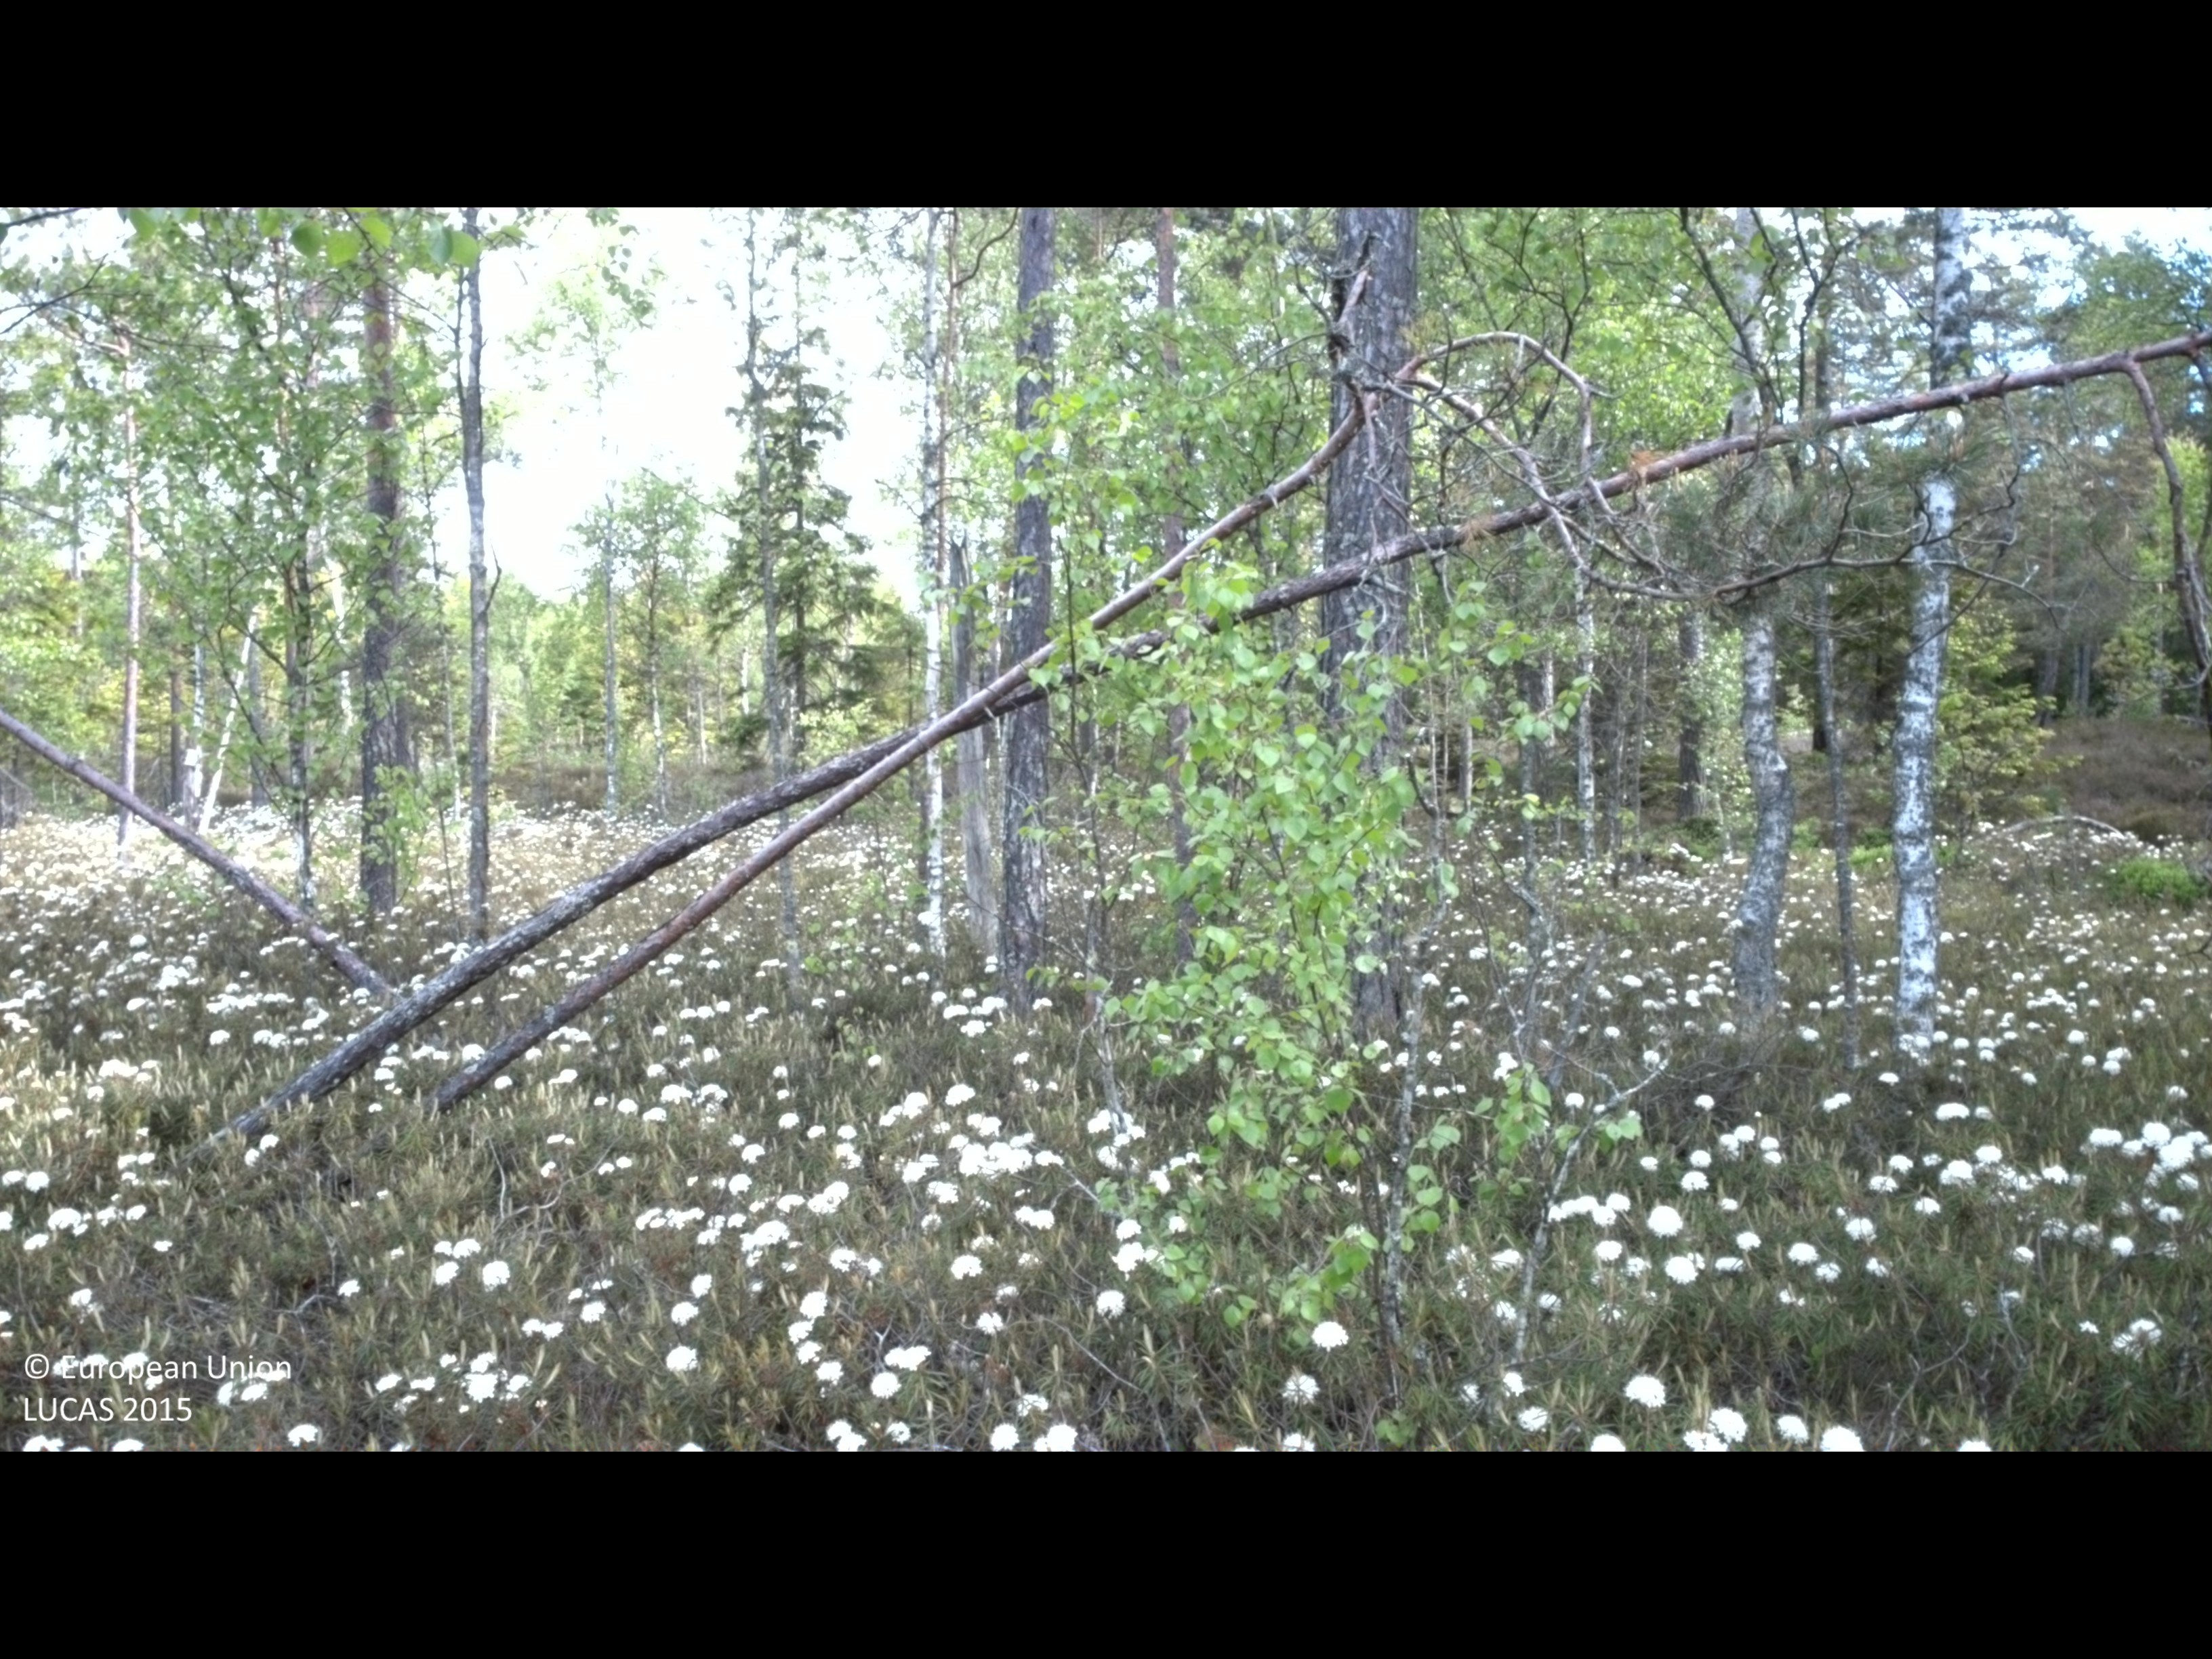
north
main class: Woodland
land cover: Pine dominated mixed woodland
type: boreal forest
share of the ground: > 75 %
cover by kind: coniferous forest trees 60 %, broadleaved forest trees 25 %, shrubs 15 %
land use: Forestry
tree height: > 5 m
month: May
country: SE
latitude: 57.3242
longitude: 16.4598
